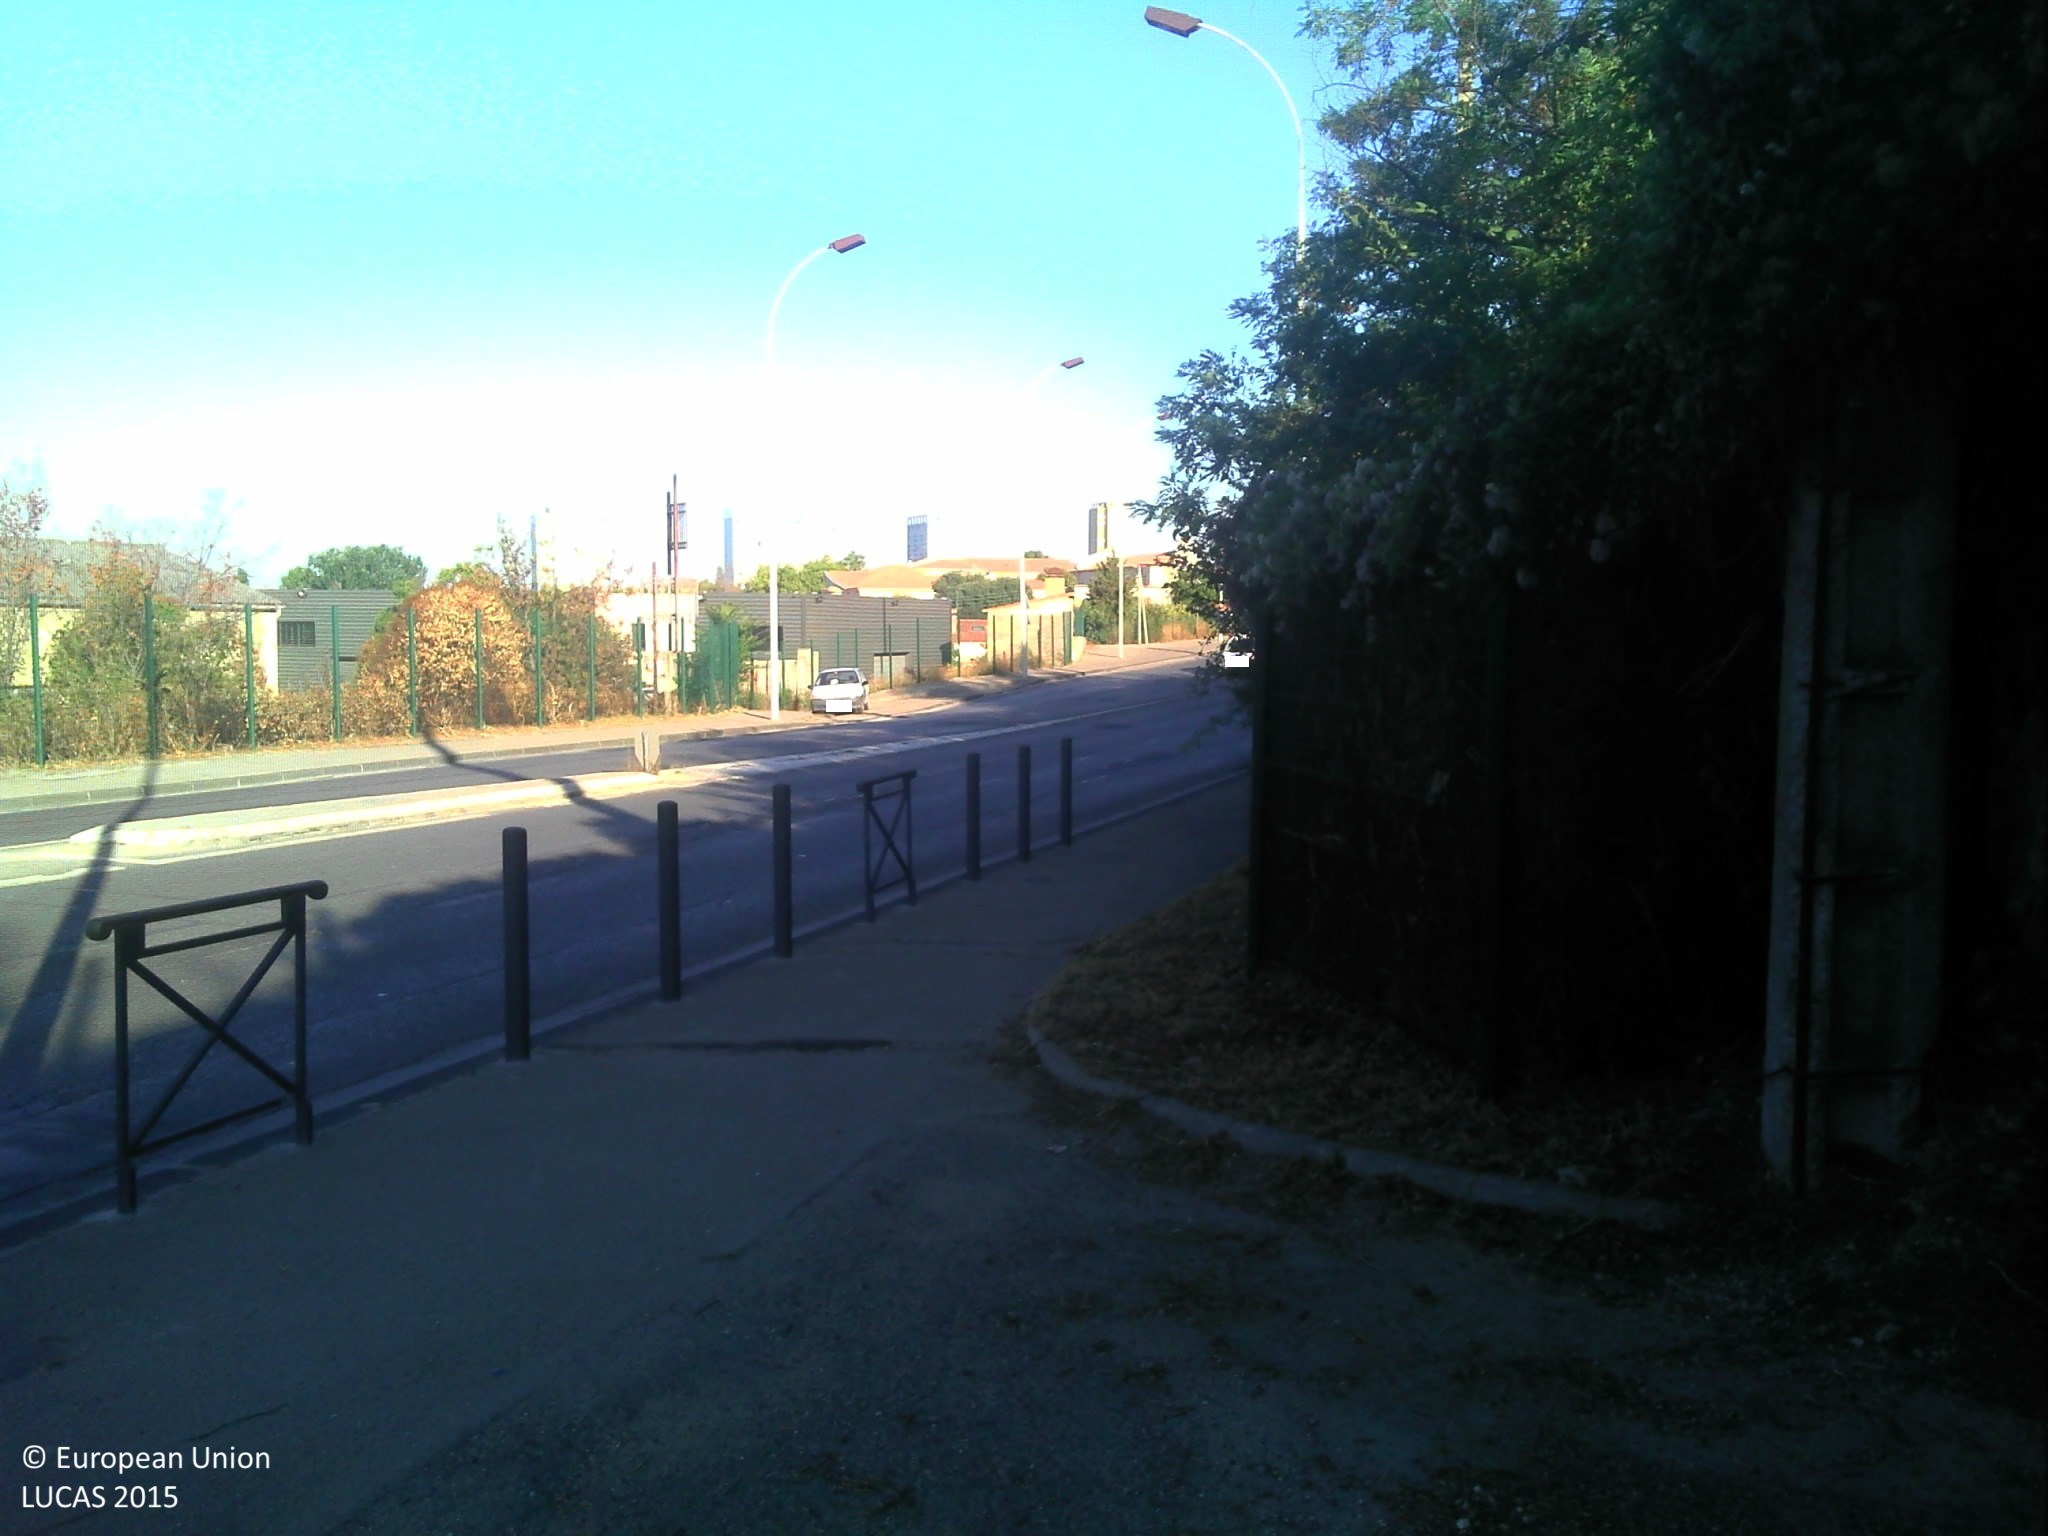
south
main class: Grassland
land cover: Spontaneously vegetated surfaces
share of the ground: > 75 %
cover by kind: consolidated bare surface 70 %, herbaceous plants 30 %
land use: Railway transport
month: August
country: FR
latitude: 43.3444
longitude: 5.3843
